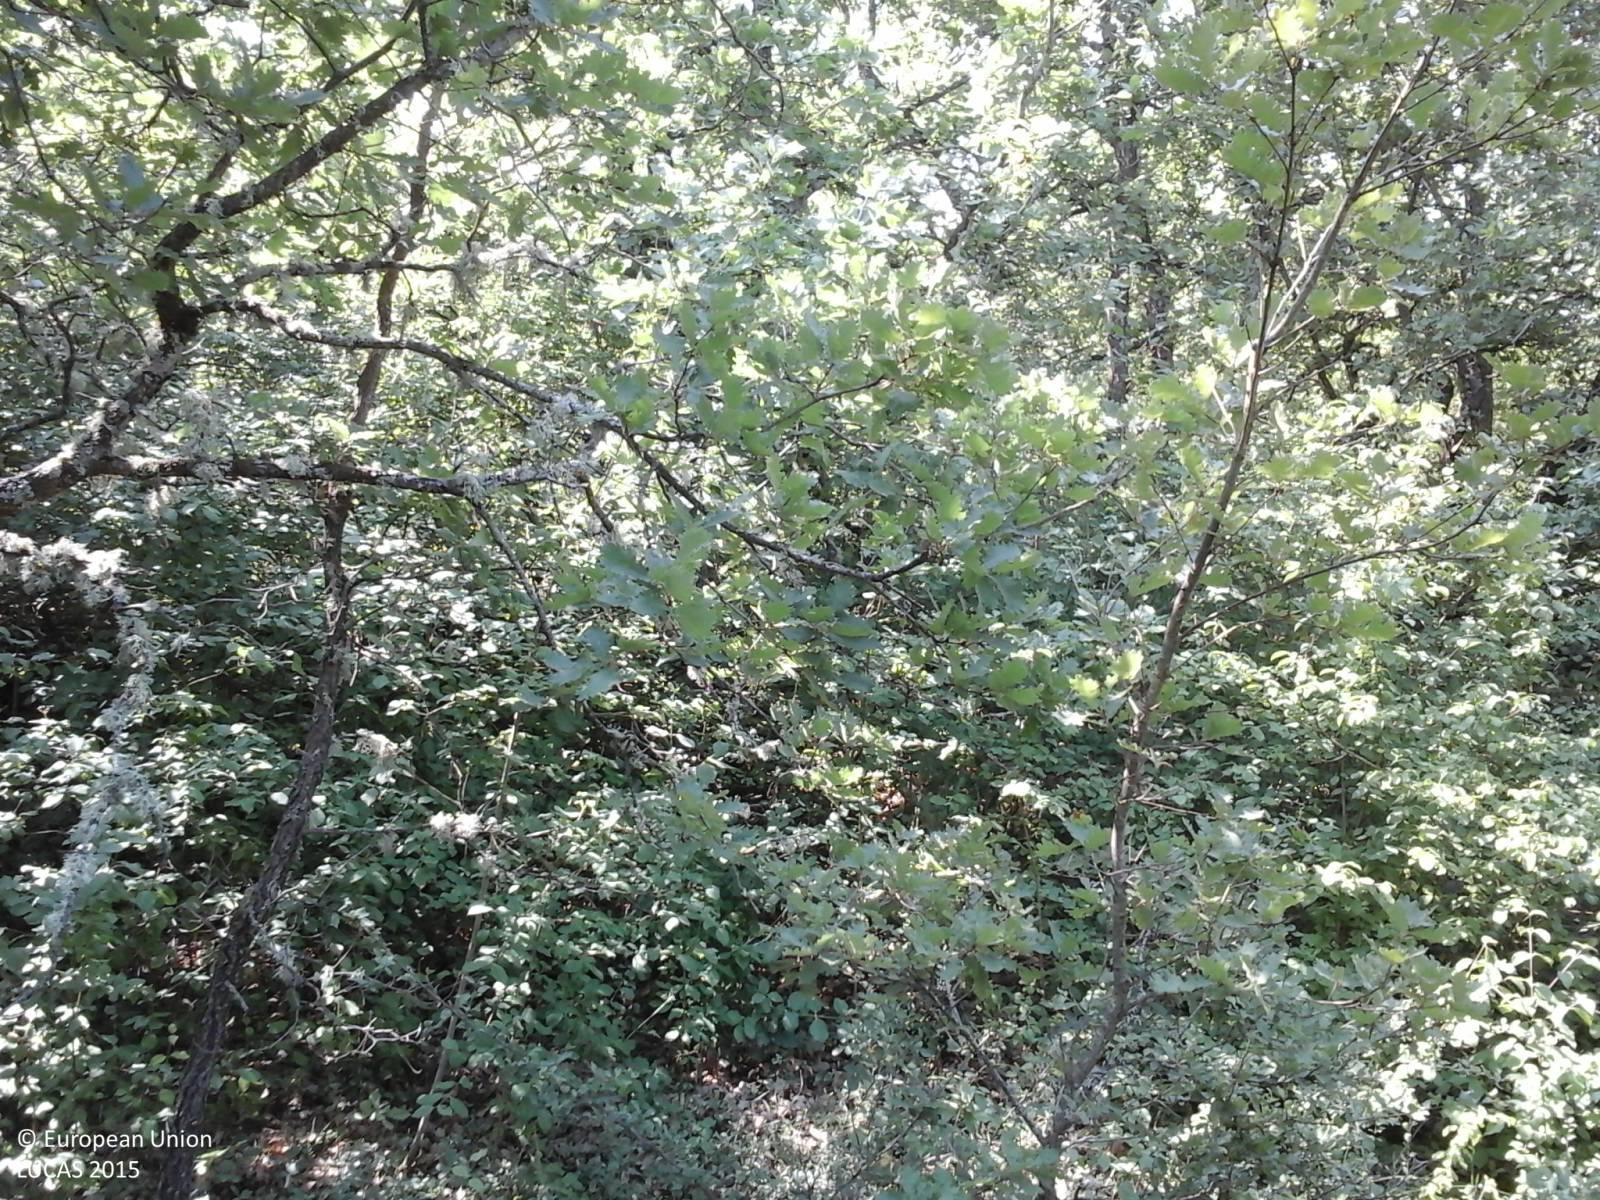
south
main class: Woodland
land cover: Broadleaved woodland
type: thermophilous deciduous forest
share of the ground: > 75 %
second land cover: Grassland without tree/shrub cover
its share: > 75 %
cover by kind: broadleaved forest trees 80 %, shrubs 10 %, herbaceous plants 10 %
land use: Forestry
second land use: Agriculture (excluding fallow land and kitchen gardens)
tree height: > 5 m
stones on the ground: 25 - 50 %
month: July
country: IT
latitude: 42.3463
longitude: 13.3274
